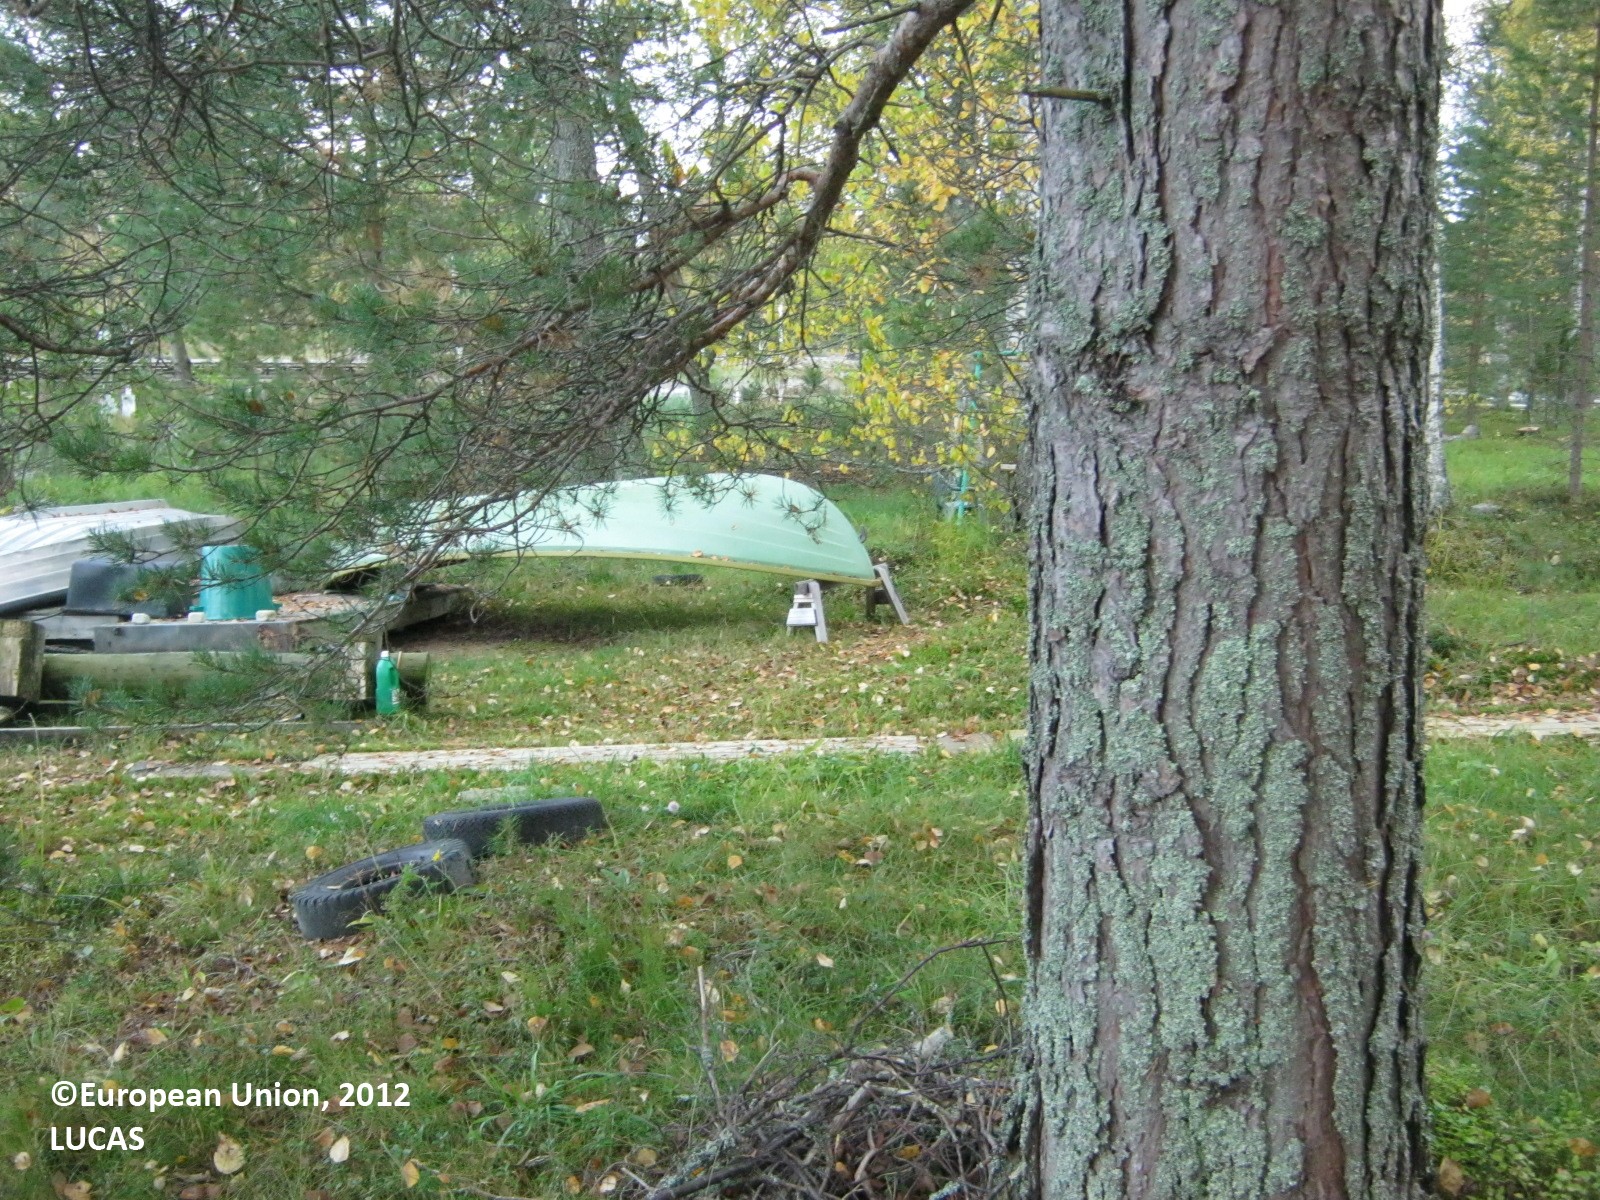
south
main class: Woodland
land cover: Other mixed woodland
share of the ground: 25 - 50 %
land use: Residential
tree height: > 5 m
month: September
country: FI
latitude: 62.3283
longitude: 28.7617
